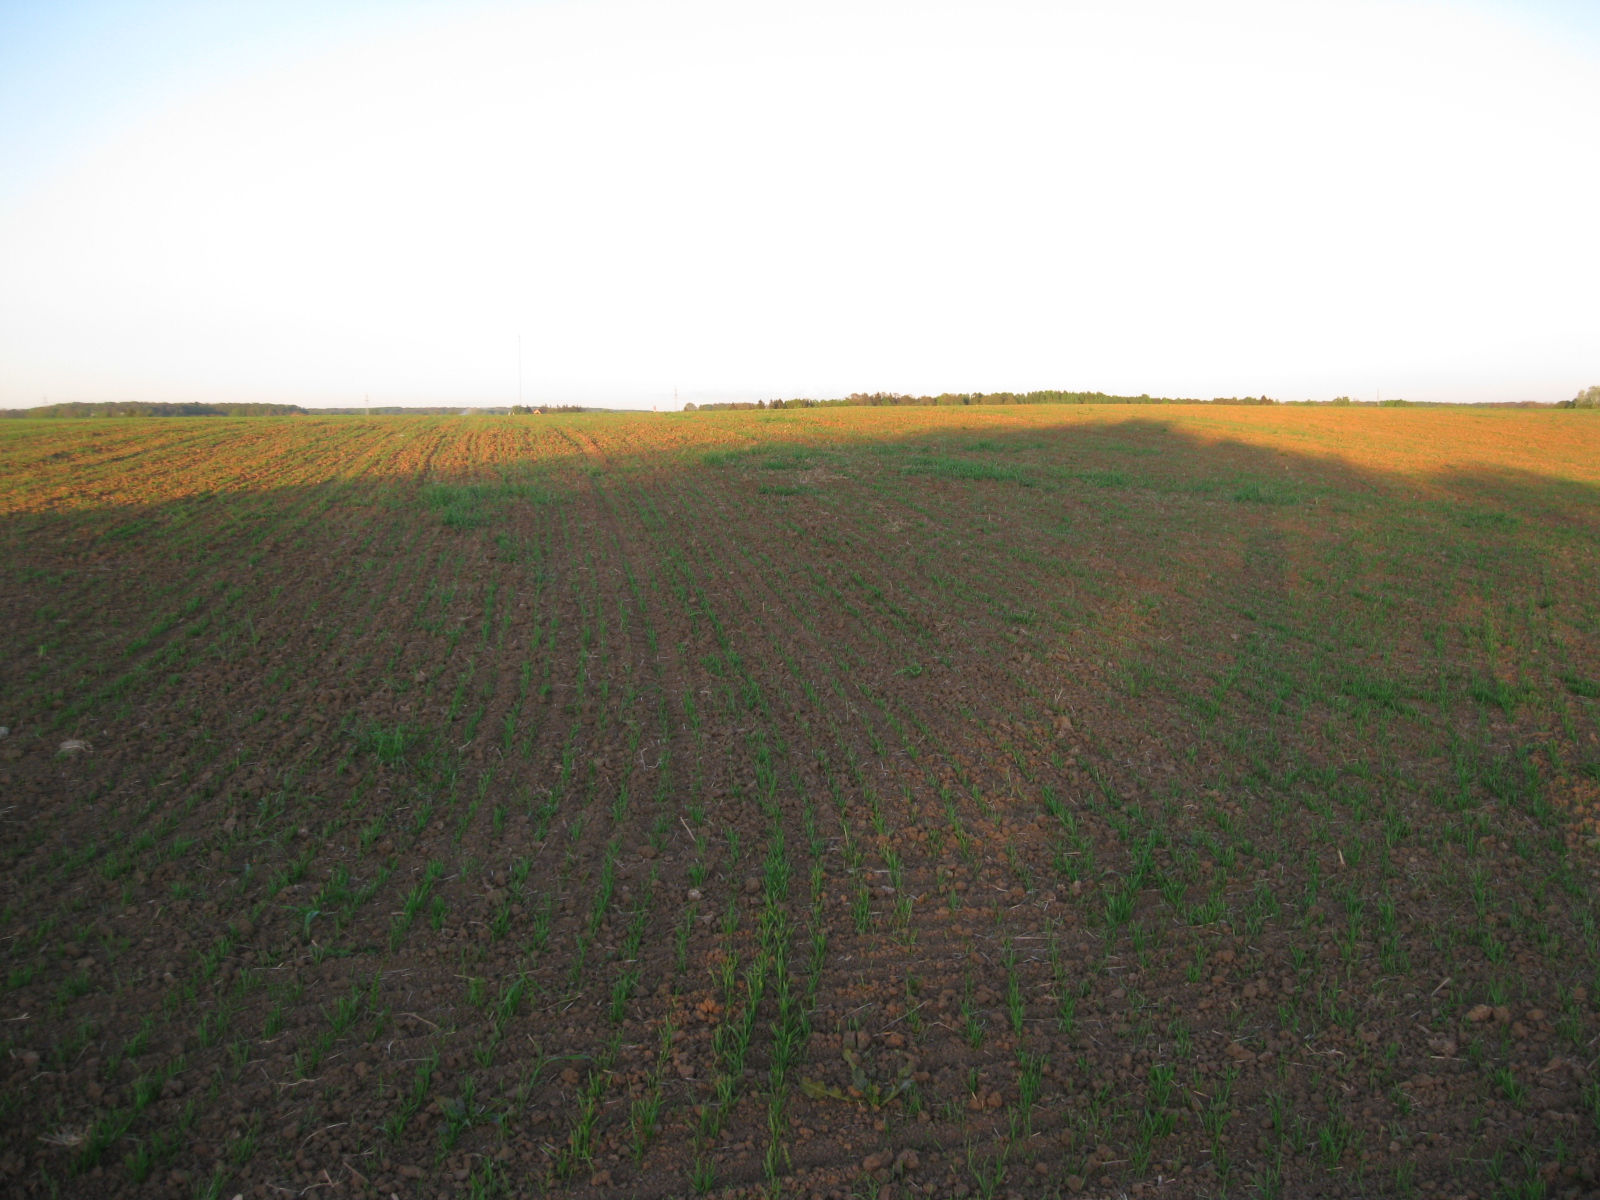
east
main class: Cropland
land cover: Common wheat
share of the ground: < 10 %
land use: Agriculture (excluding fallow land and kitchen gardens)
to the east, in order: Common wheat
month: May
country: LT
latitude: 56.1168
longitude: 24.4263
